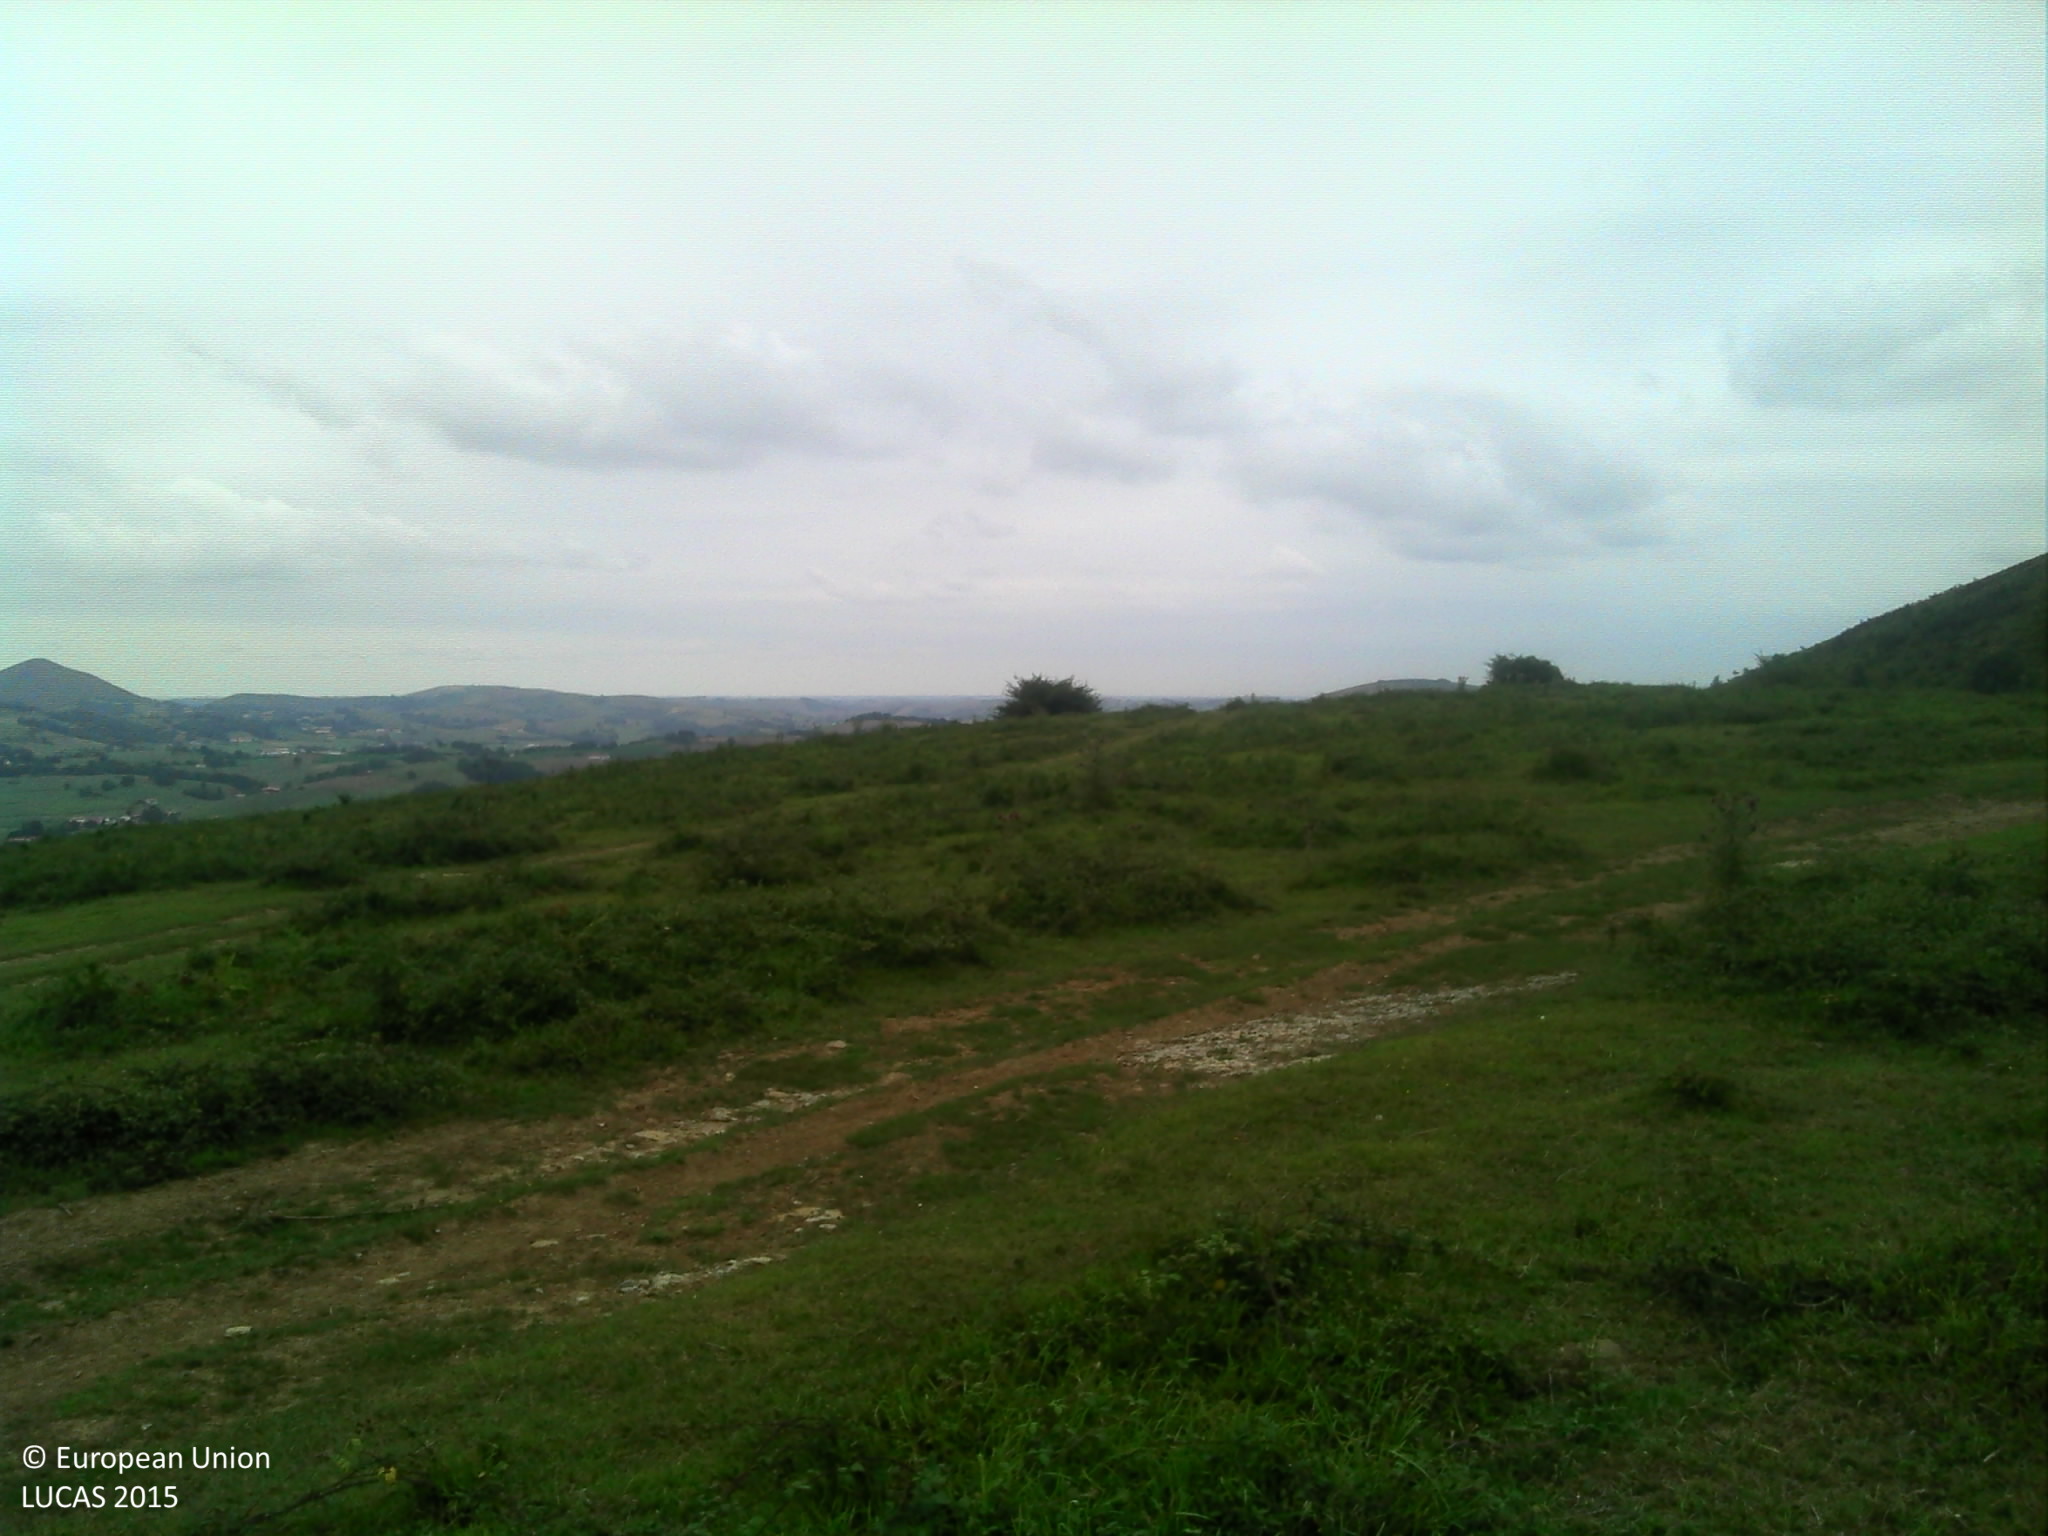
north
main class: Grassland
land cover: Grassland without tree/shrub cover
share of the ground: > 75 %
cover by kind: herbaceous plants 95 %, shrubs 5 %
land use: Agriculture (excluding fallow land and kitchen gardens)
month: August
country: FR
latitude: 43.2552
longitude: -1.1610
